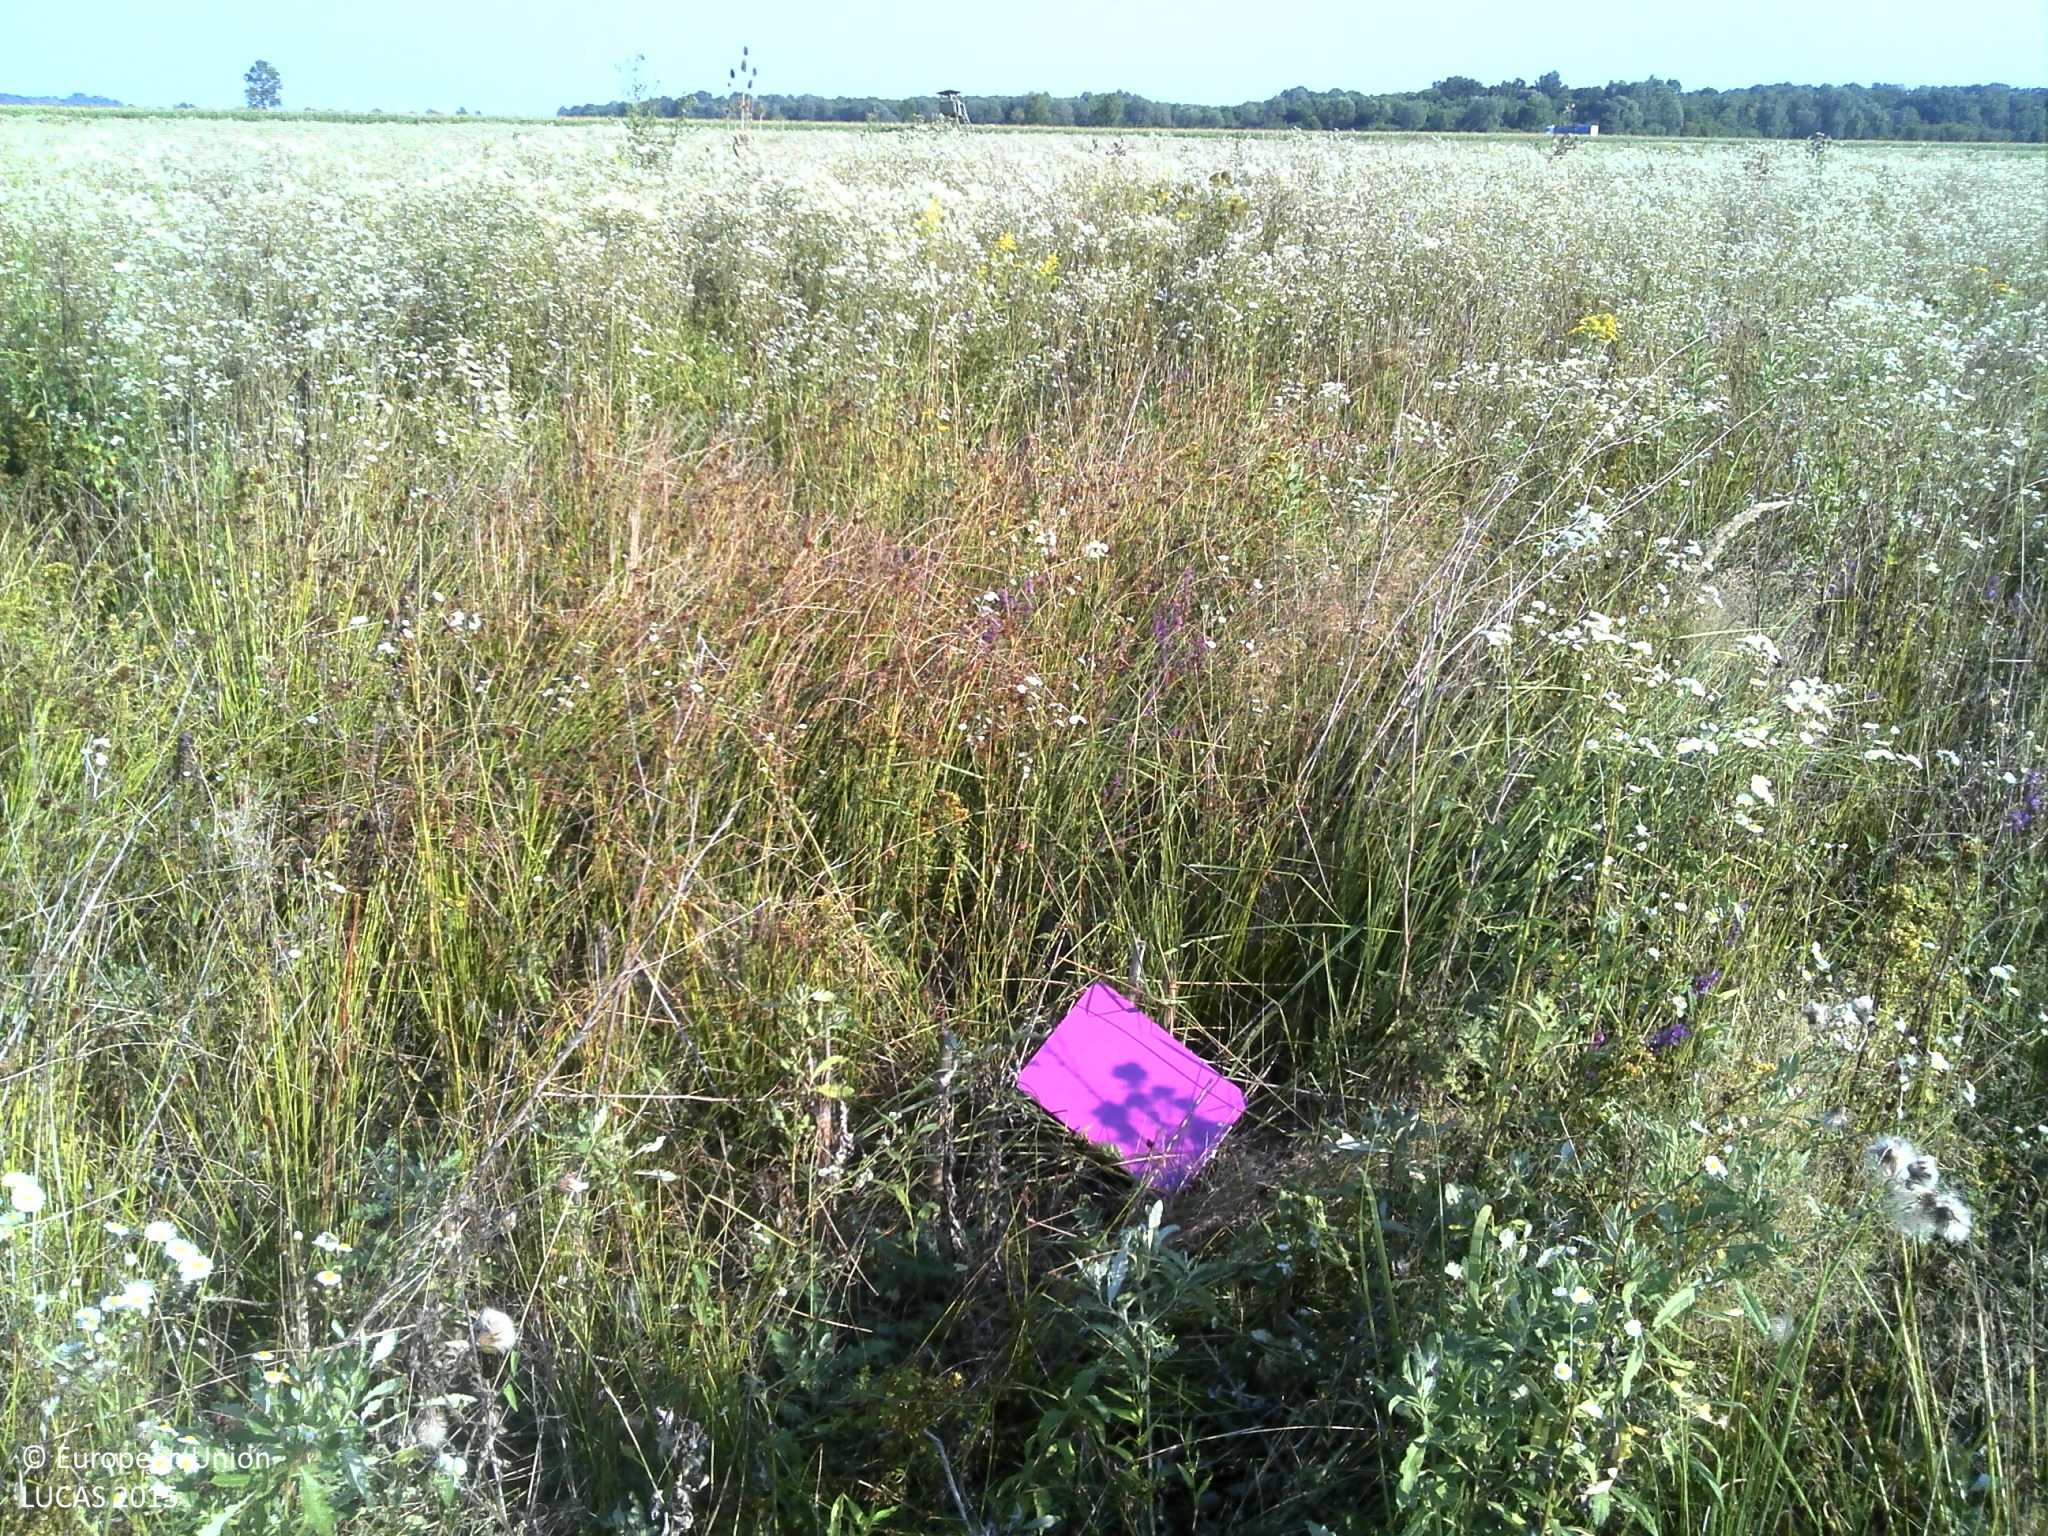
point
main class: Grassland
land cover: Spontaneously vegetated surfaces
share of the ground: > 75 %
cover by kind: herbaceous plants 100 %
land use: Fallow land
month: August
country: HR
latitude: 45.6862
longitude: 16.4572
